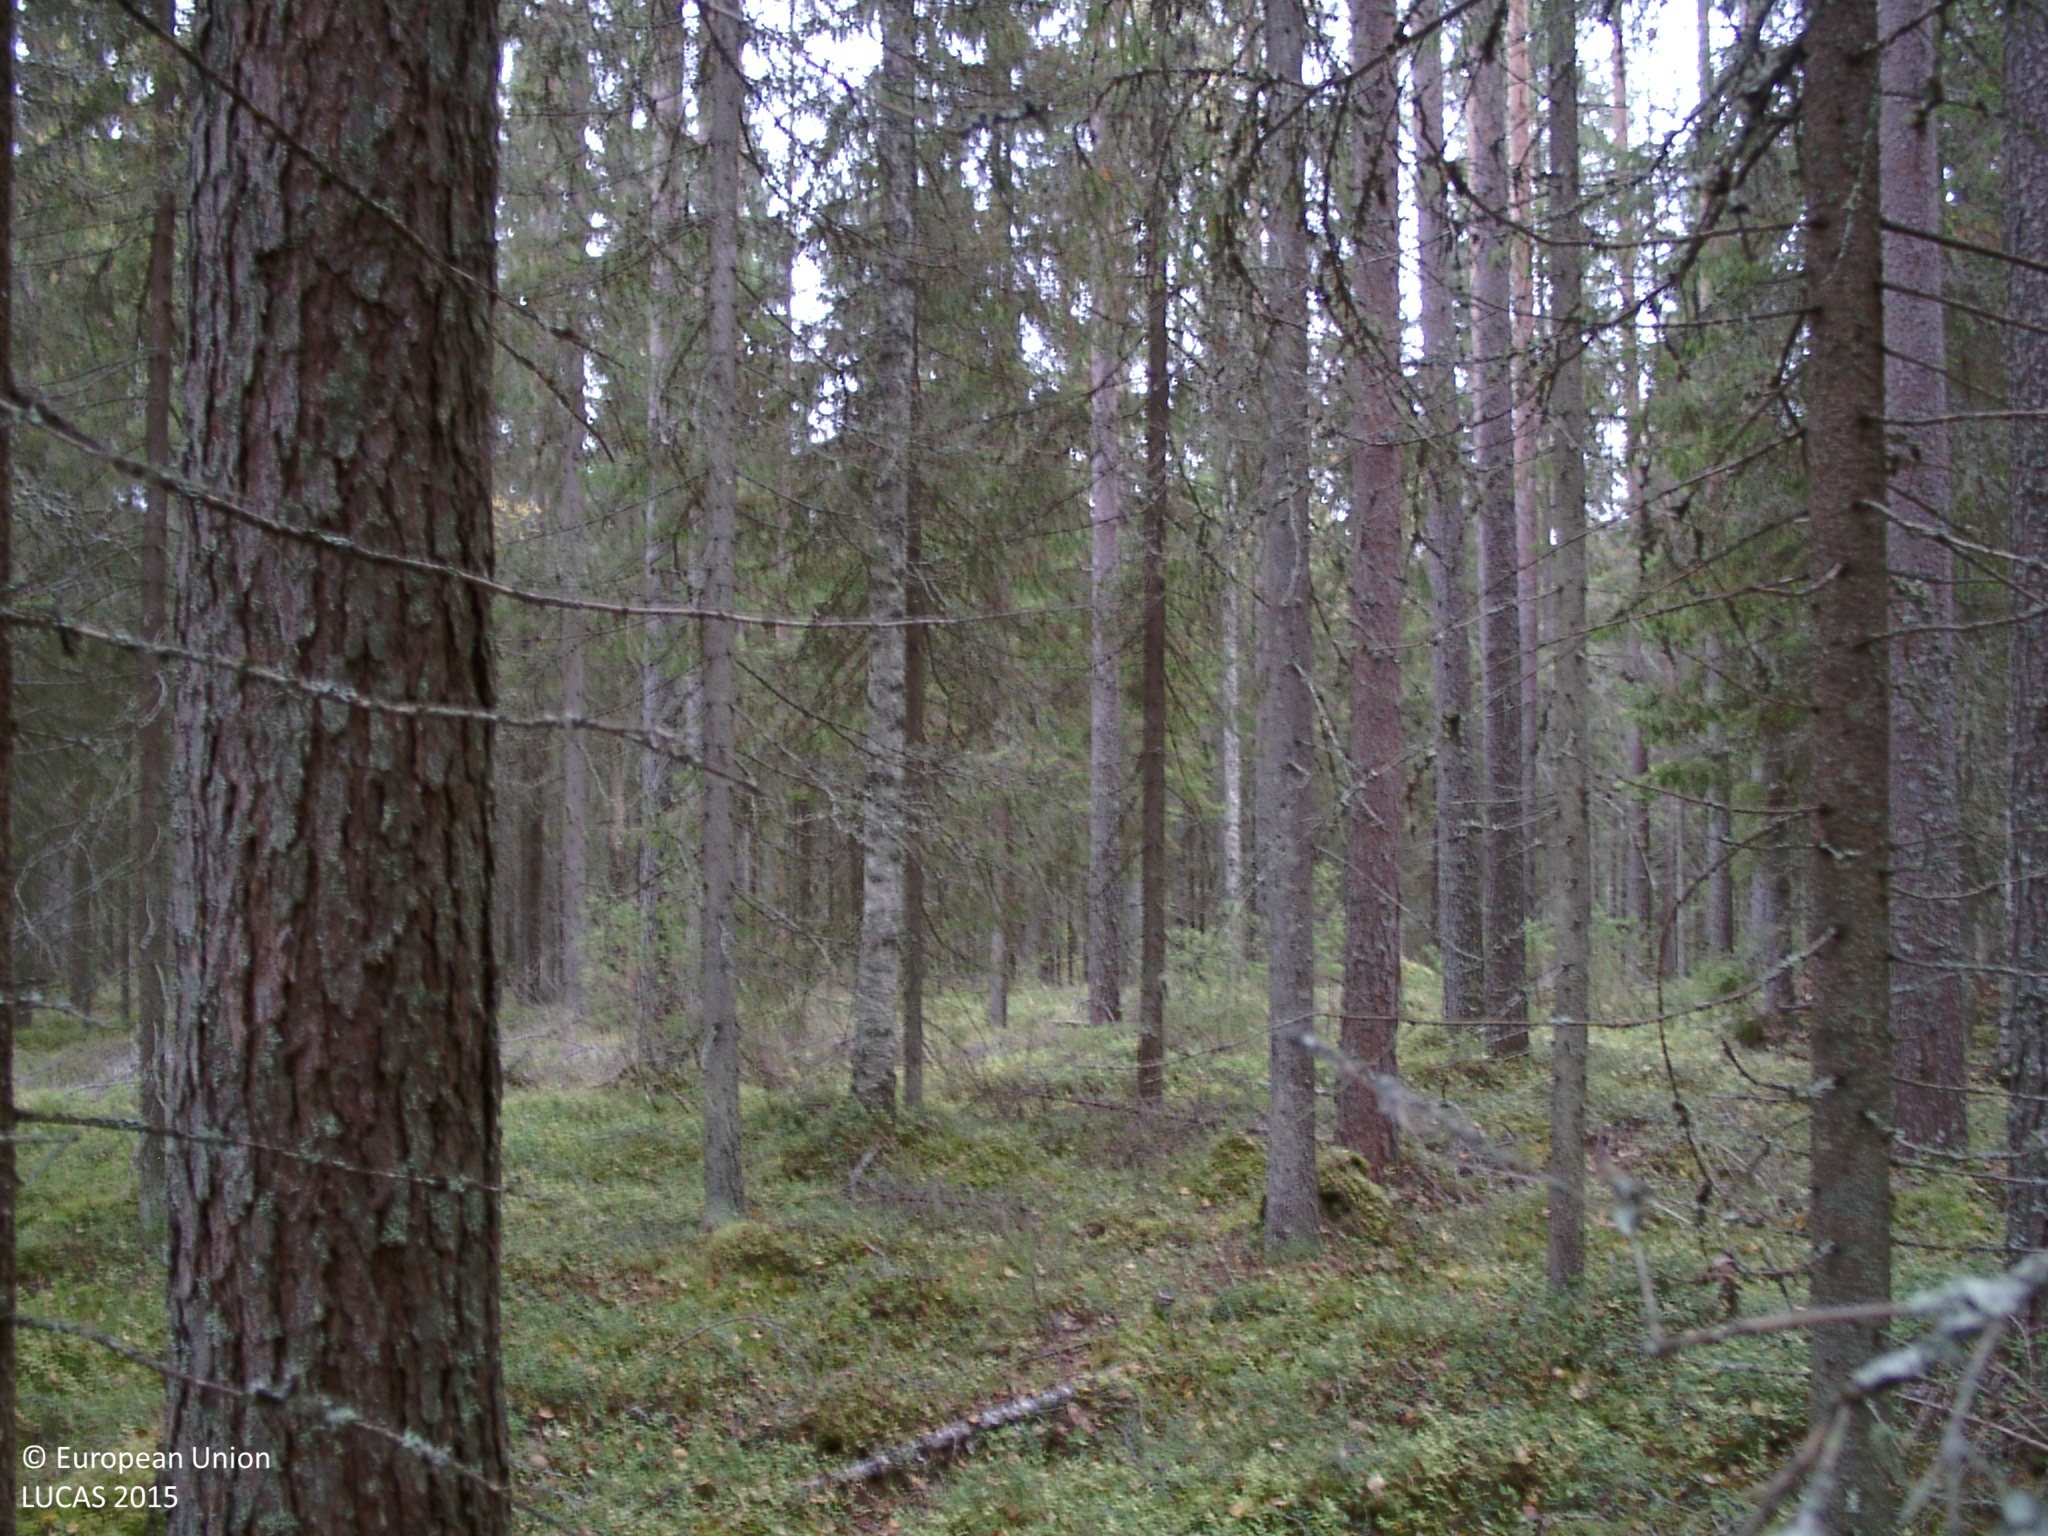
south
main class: Woodland
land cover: Spruce dominated coniferous woodland
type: boreal forest
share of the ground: 50 - 75 %
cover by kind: coniferous forest trees 65 %, shrubs 15 %, lichens and mosses 15 %, broadleaved forest trees 5 %
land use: Forestry
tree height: > 5 m
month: September
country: FI
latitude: 62.5941
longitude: 25.1562
